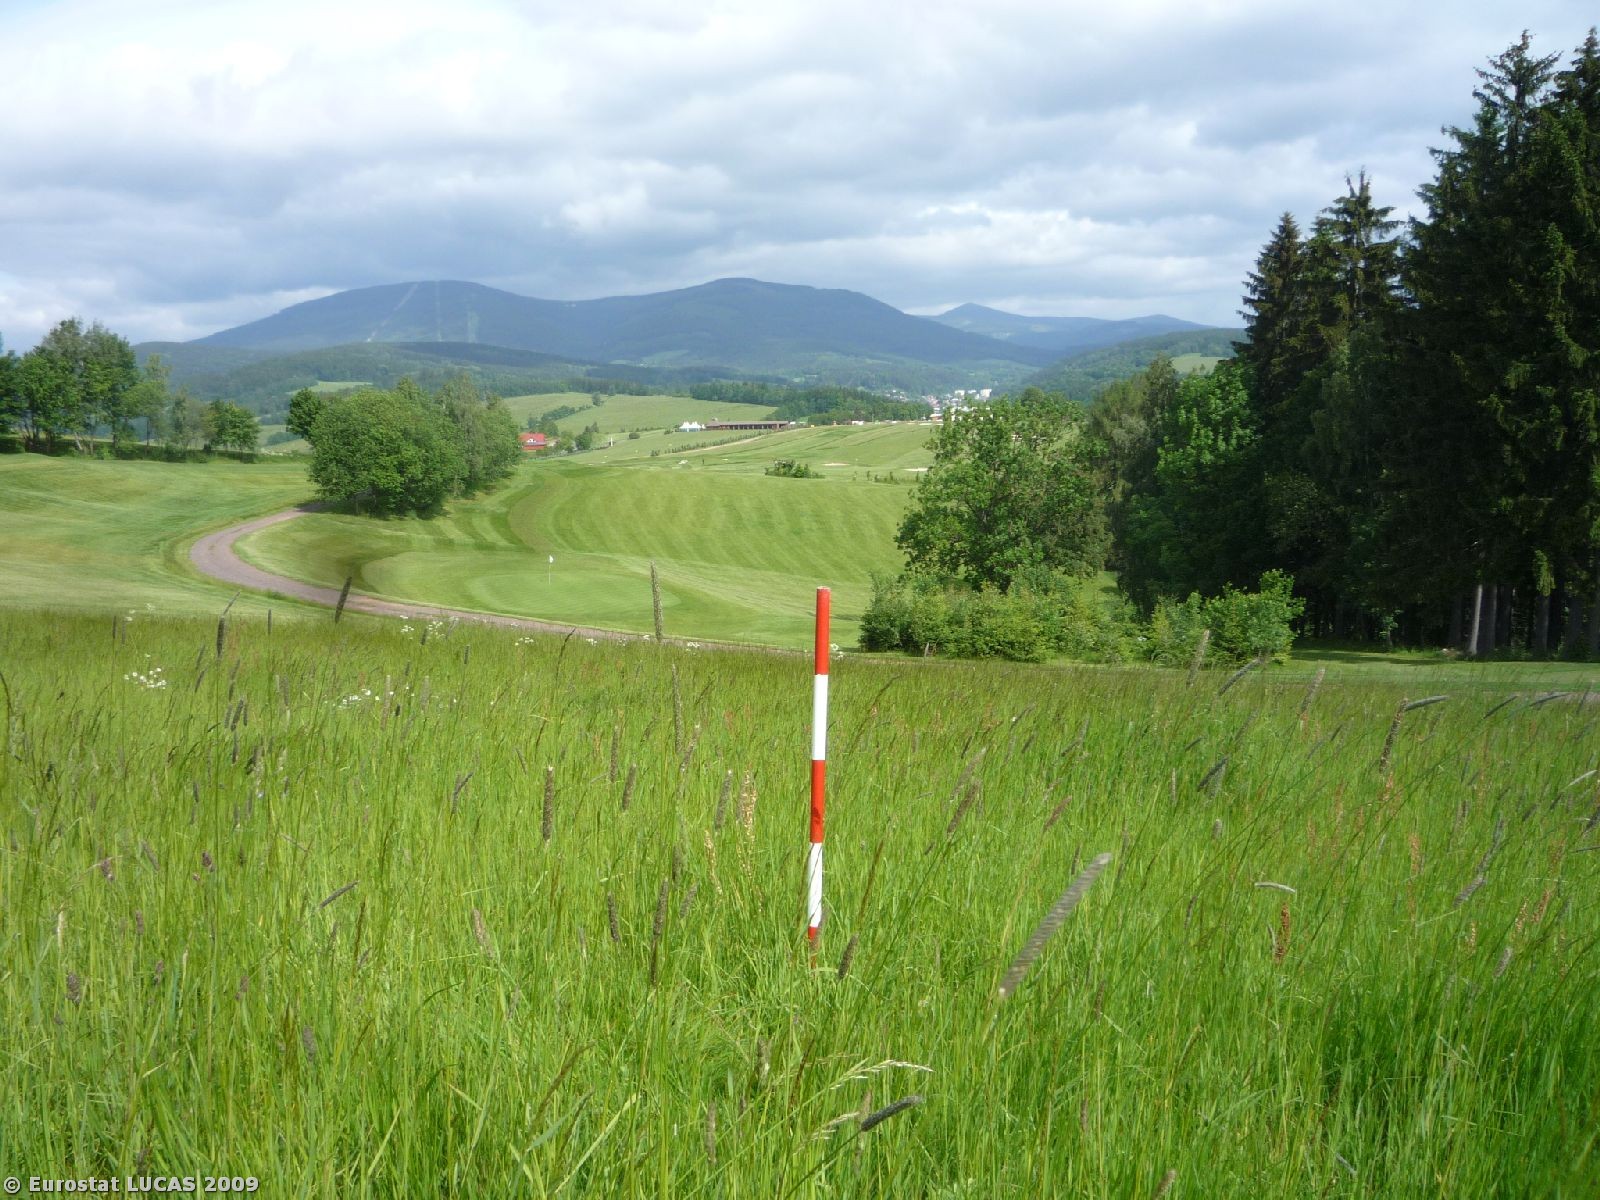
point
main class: Grassland
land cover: Grassland without tree/shrub cover
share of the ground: > 75 %
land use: Sport
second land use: Amenities, museums, leisure
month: June
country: CZ
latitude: 50.5935
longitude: 15.8394
